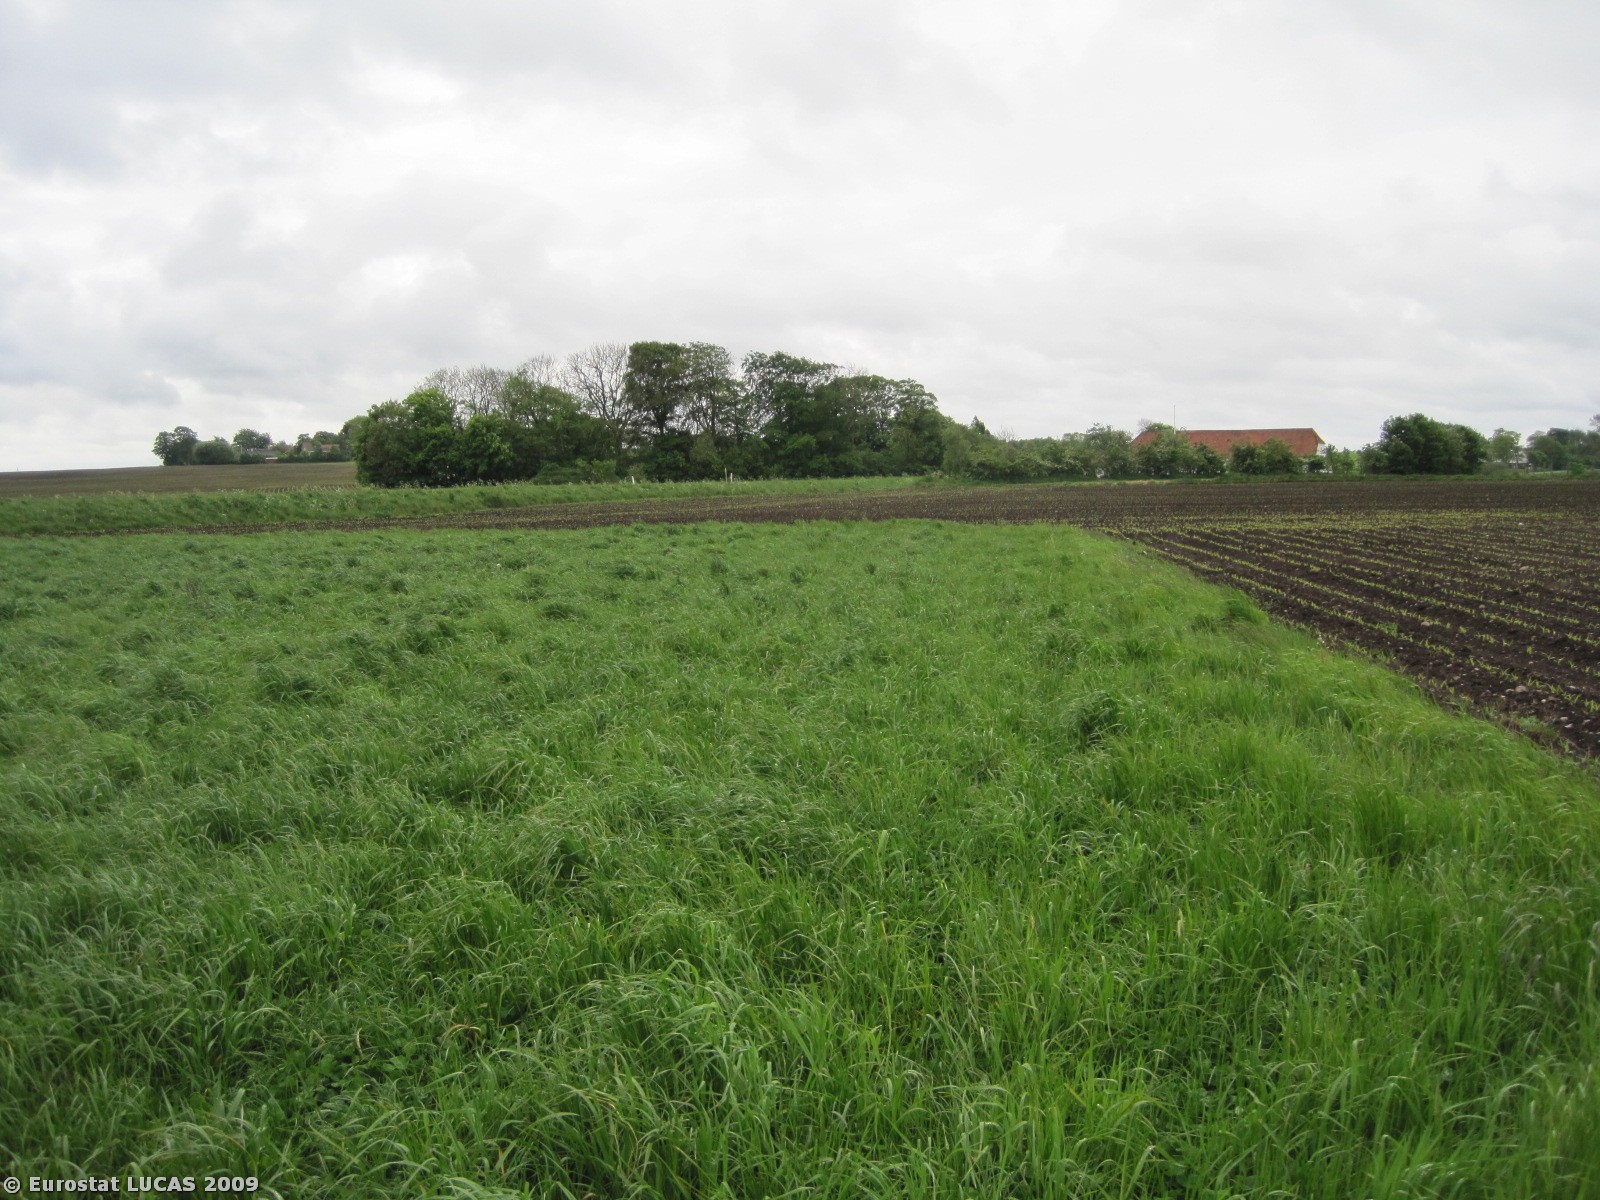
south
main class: Grassland
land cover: Grassland without tree/shrub cover
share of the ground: > 75 %
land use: Agriculture (excluding fallow land and kitchen gardens)
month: May
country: DK
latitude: 56.8345
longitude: 9.6890
